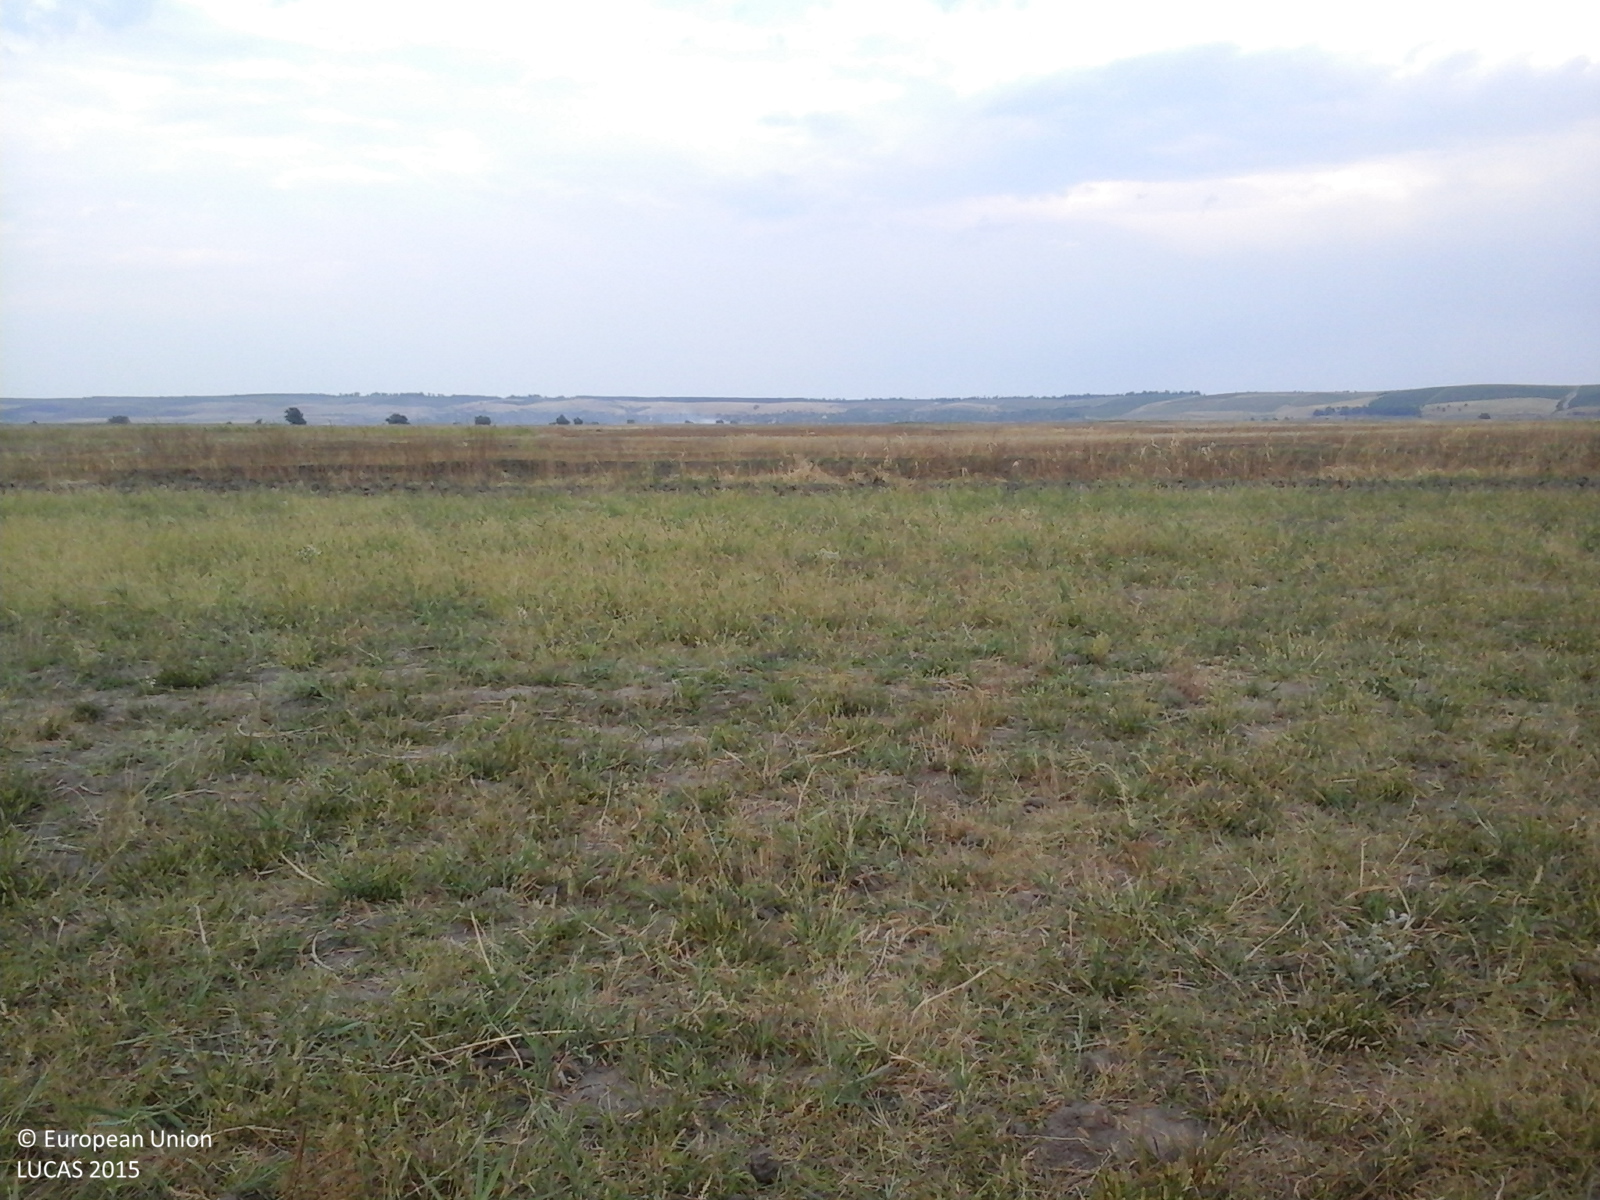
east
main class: Grassland
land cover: Grassland without tree/shrub cover
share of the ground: > 75 %
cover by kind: herbaceous plants 100 %
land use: Agriculture (excluding fallow land and kitchen gardens)
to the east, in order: Grassland without tree/shrub cover; Spontaneously vegetated surfaces; Ditches and canals; Tracks; Spontaneously vegetated surfaces; Tracks; Spontaneously vegetated surfaces
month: August
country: RO
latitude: 44.3745
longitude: 22.8051
